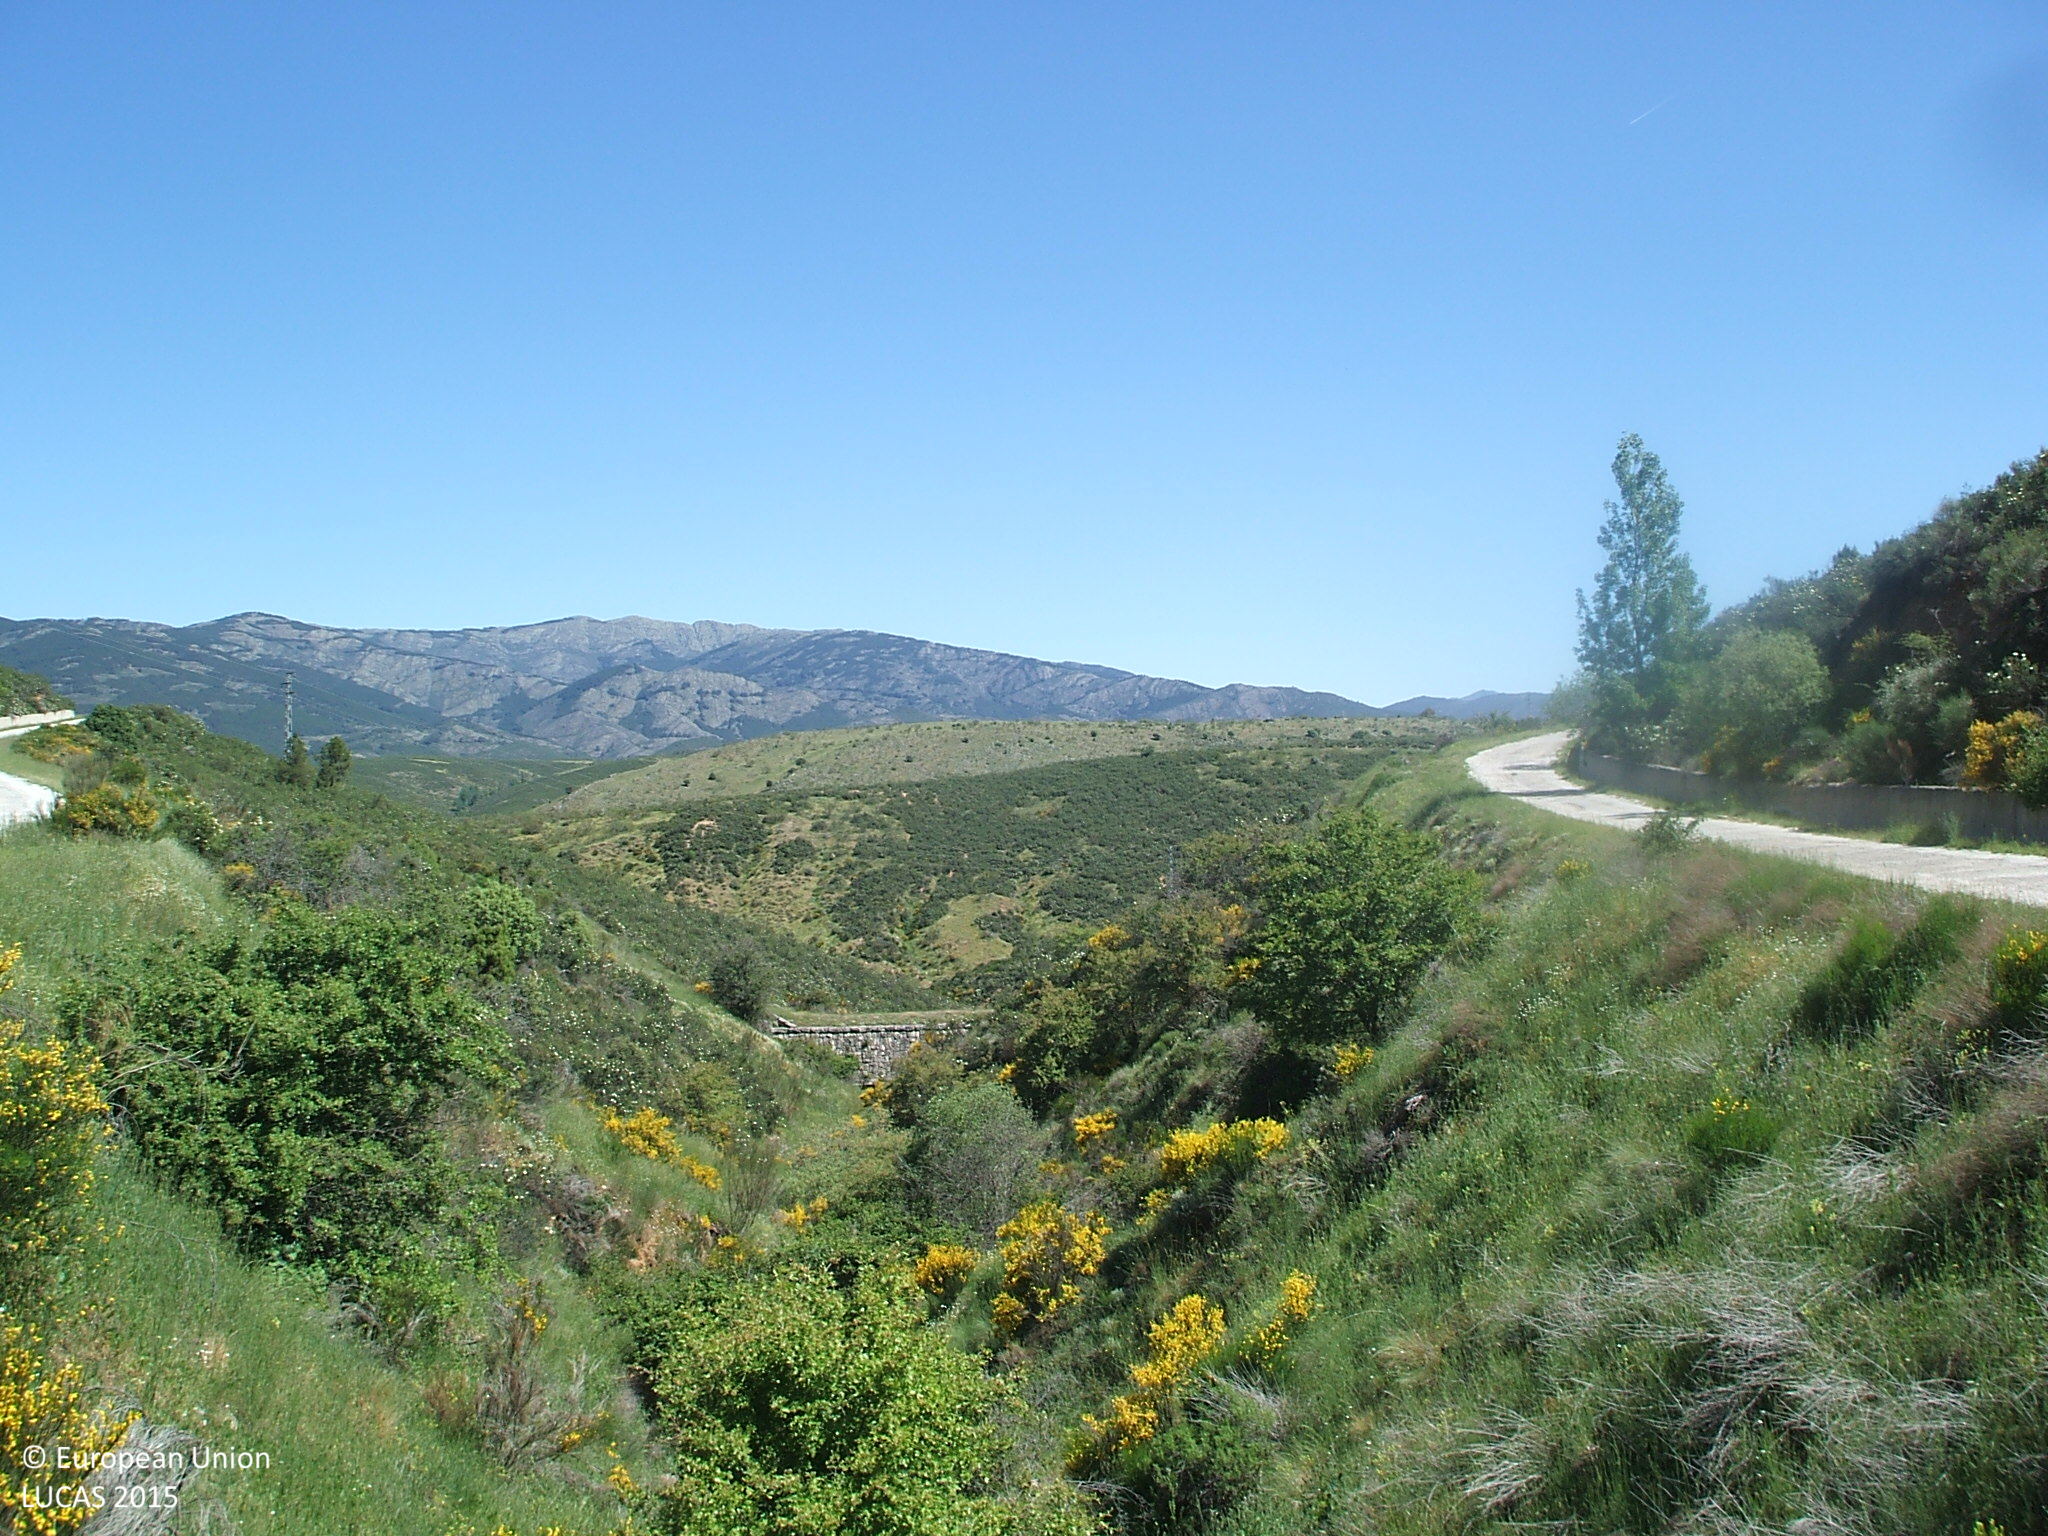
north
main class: Shrubland
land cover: Shrubland without tree cover
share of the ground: > 75 %
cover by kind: shrubs 100 %
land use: Semi-natural and natural areas not in use
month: May
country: ES
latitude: 40.8972
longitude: -3.4173
